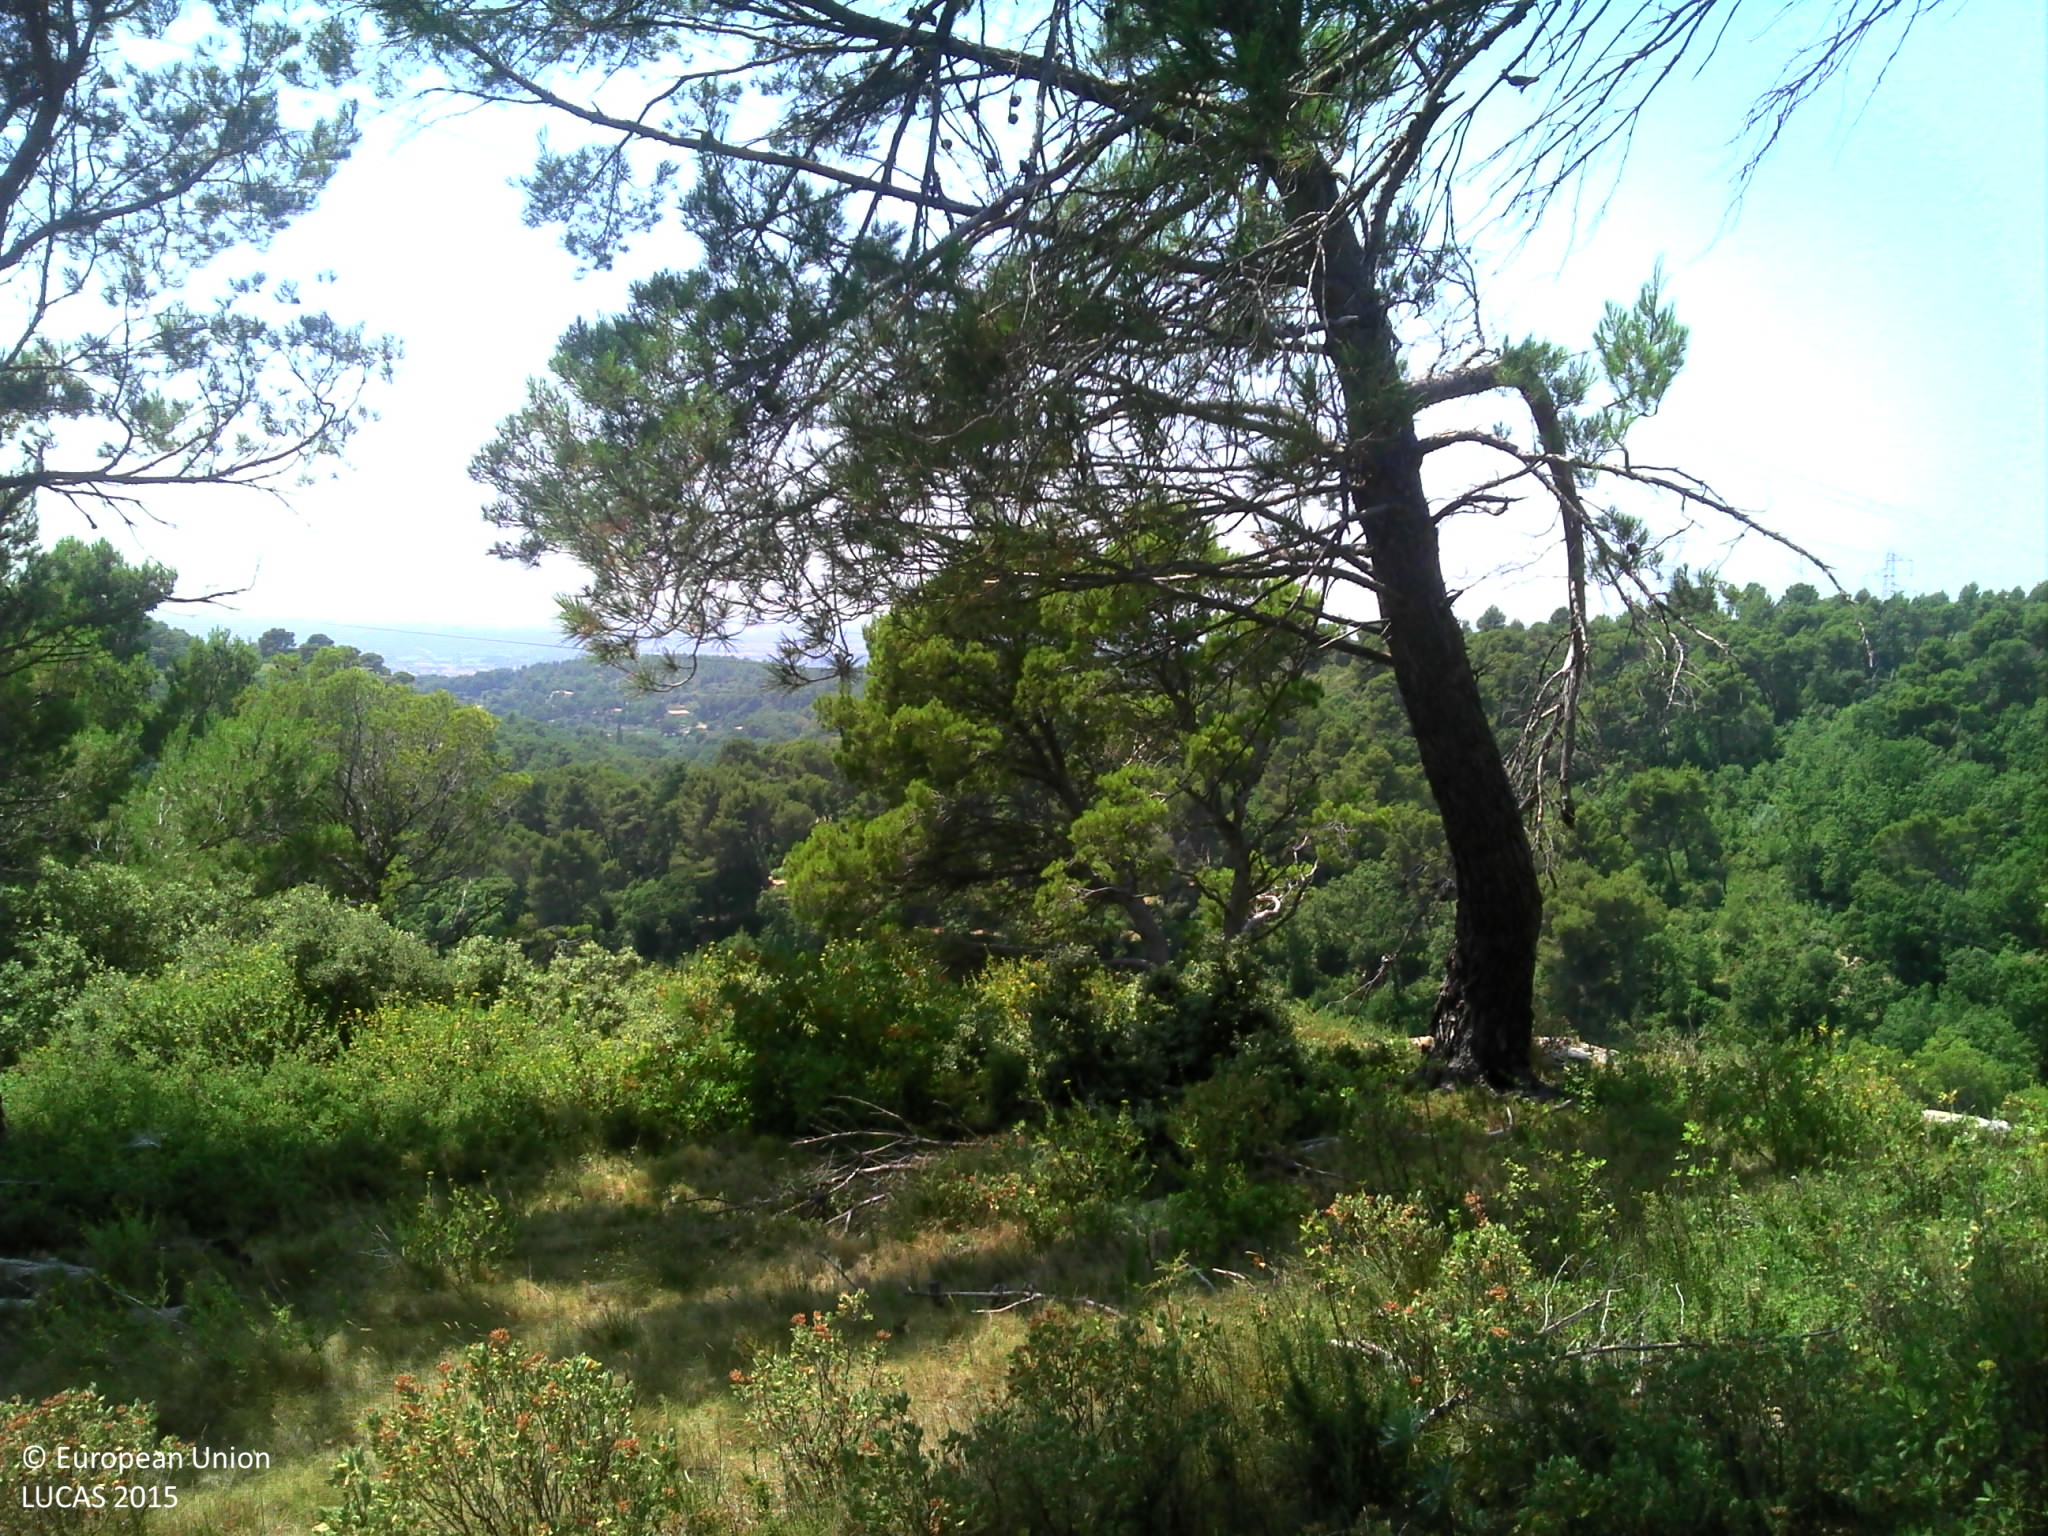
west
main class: Woodland
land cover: Pine dominated mixed woodland
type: broadleaved evergreen forest
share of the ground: > 75 %
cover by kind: shrubs 35 %, broadleaved forest trees 20 %, herbaceous plants 20 %, coniferous forest trees 15 %
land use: Forestry
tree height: > 5 m
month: July
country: FR
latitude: 43.6583
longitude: 5.1363
